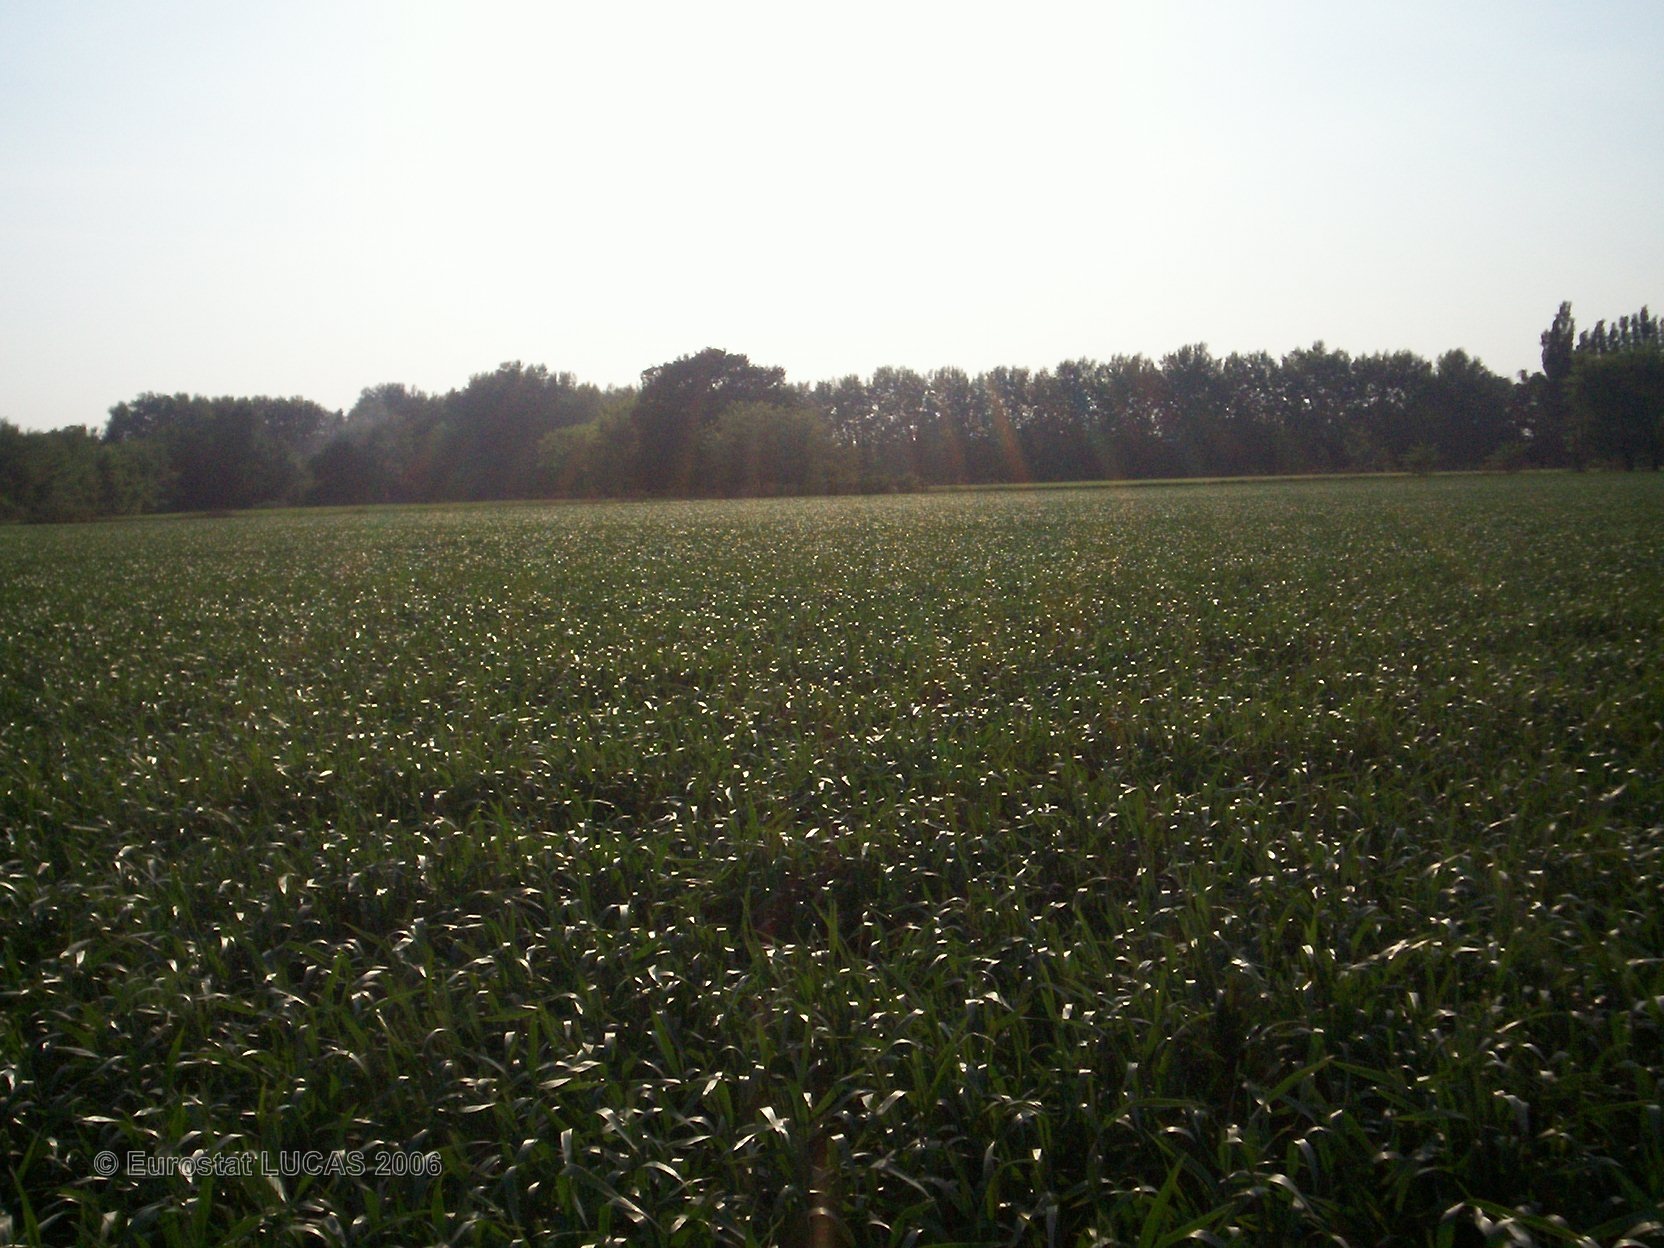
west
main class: Cropland
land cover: Durum wheat
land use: Agriculture (excluding fallow land and kitchen gardens)
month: May
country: FR
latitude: 44.0626
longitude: 4.9023
